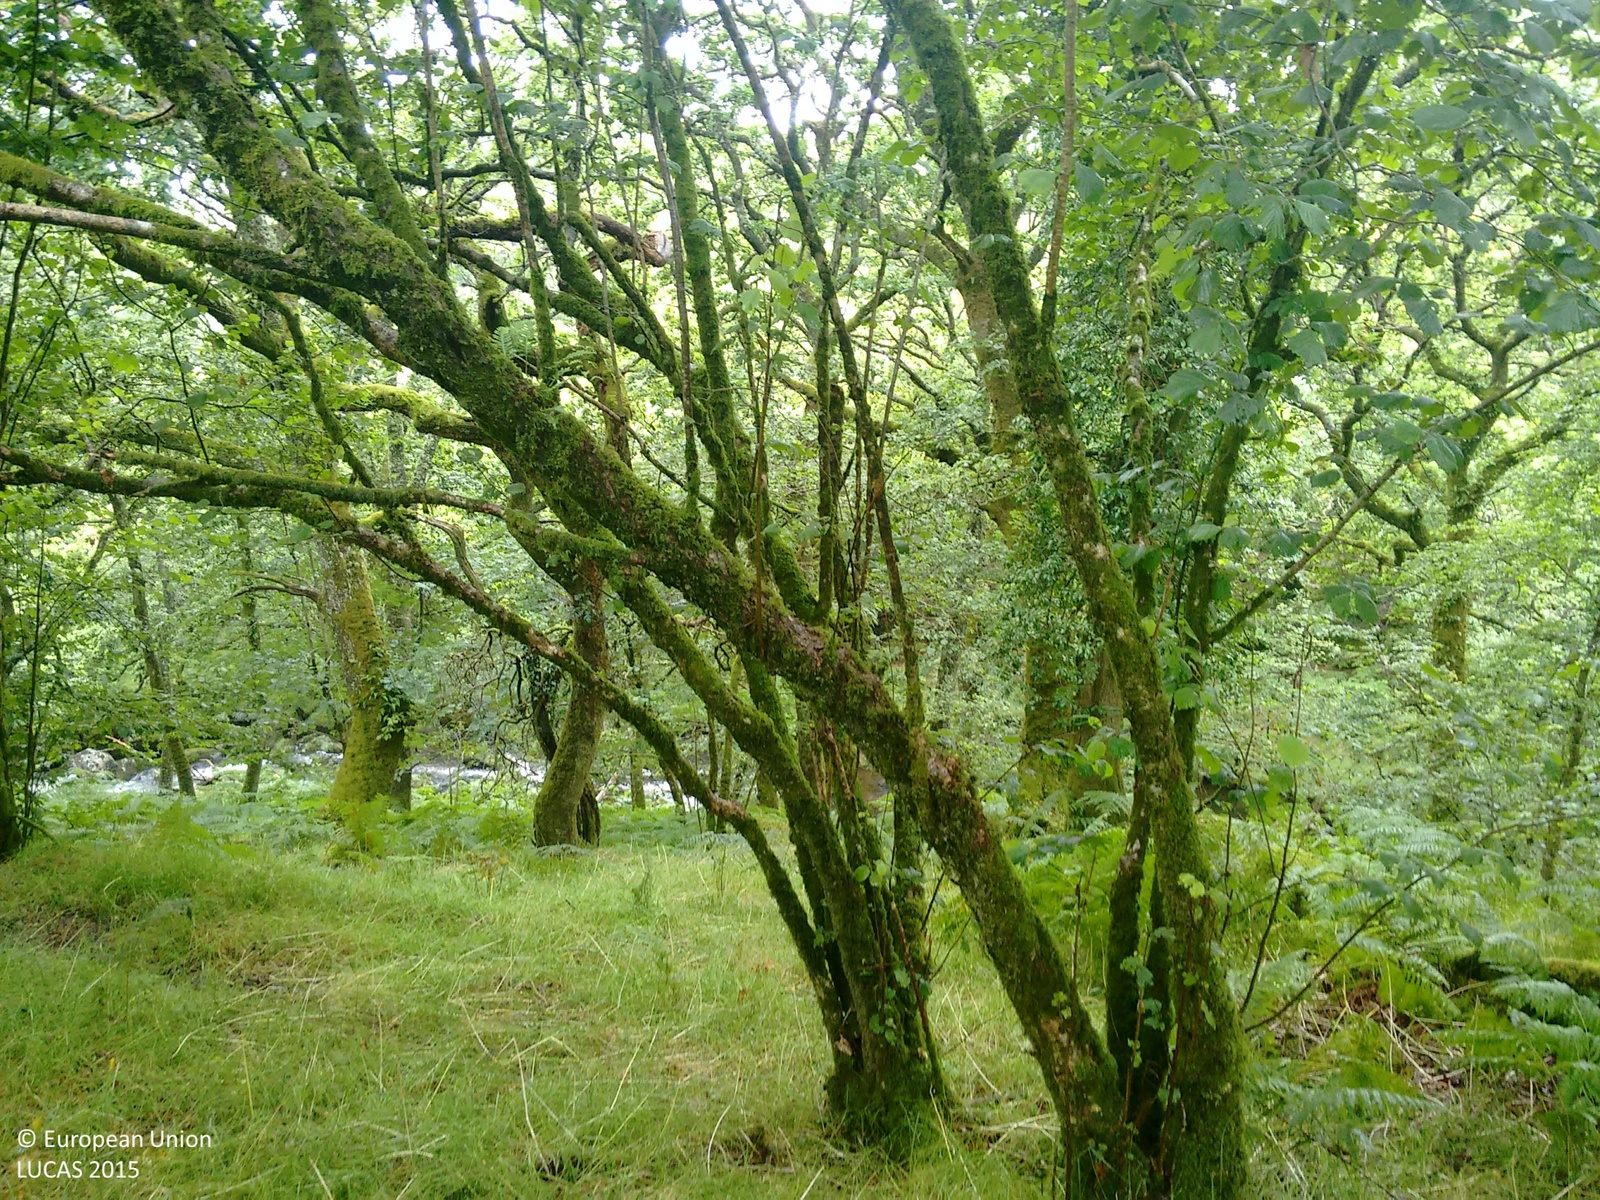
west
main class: Woodland
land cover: Broadleaved woodland
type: acidophilous oak and oak-birch forest
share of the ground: > 75 %
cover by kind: broadleaved forest trees 100 %
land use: Semi-natural and natural areas not in use
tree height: > 5 m
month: August
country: GB
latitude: 50.5498
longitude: -4.0528
